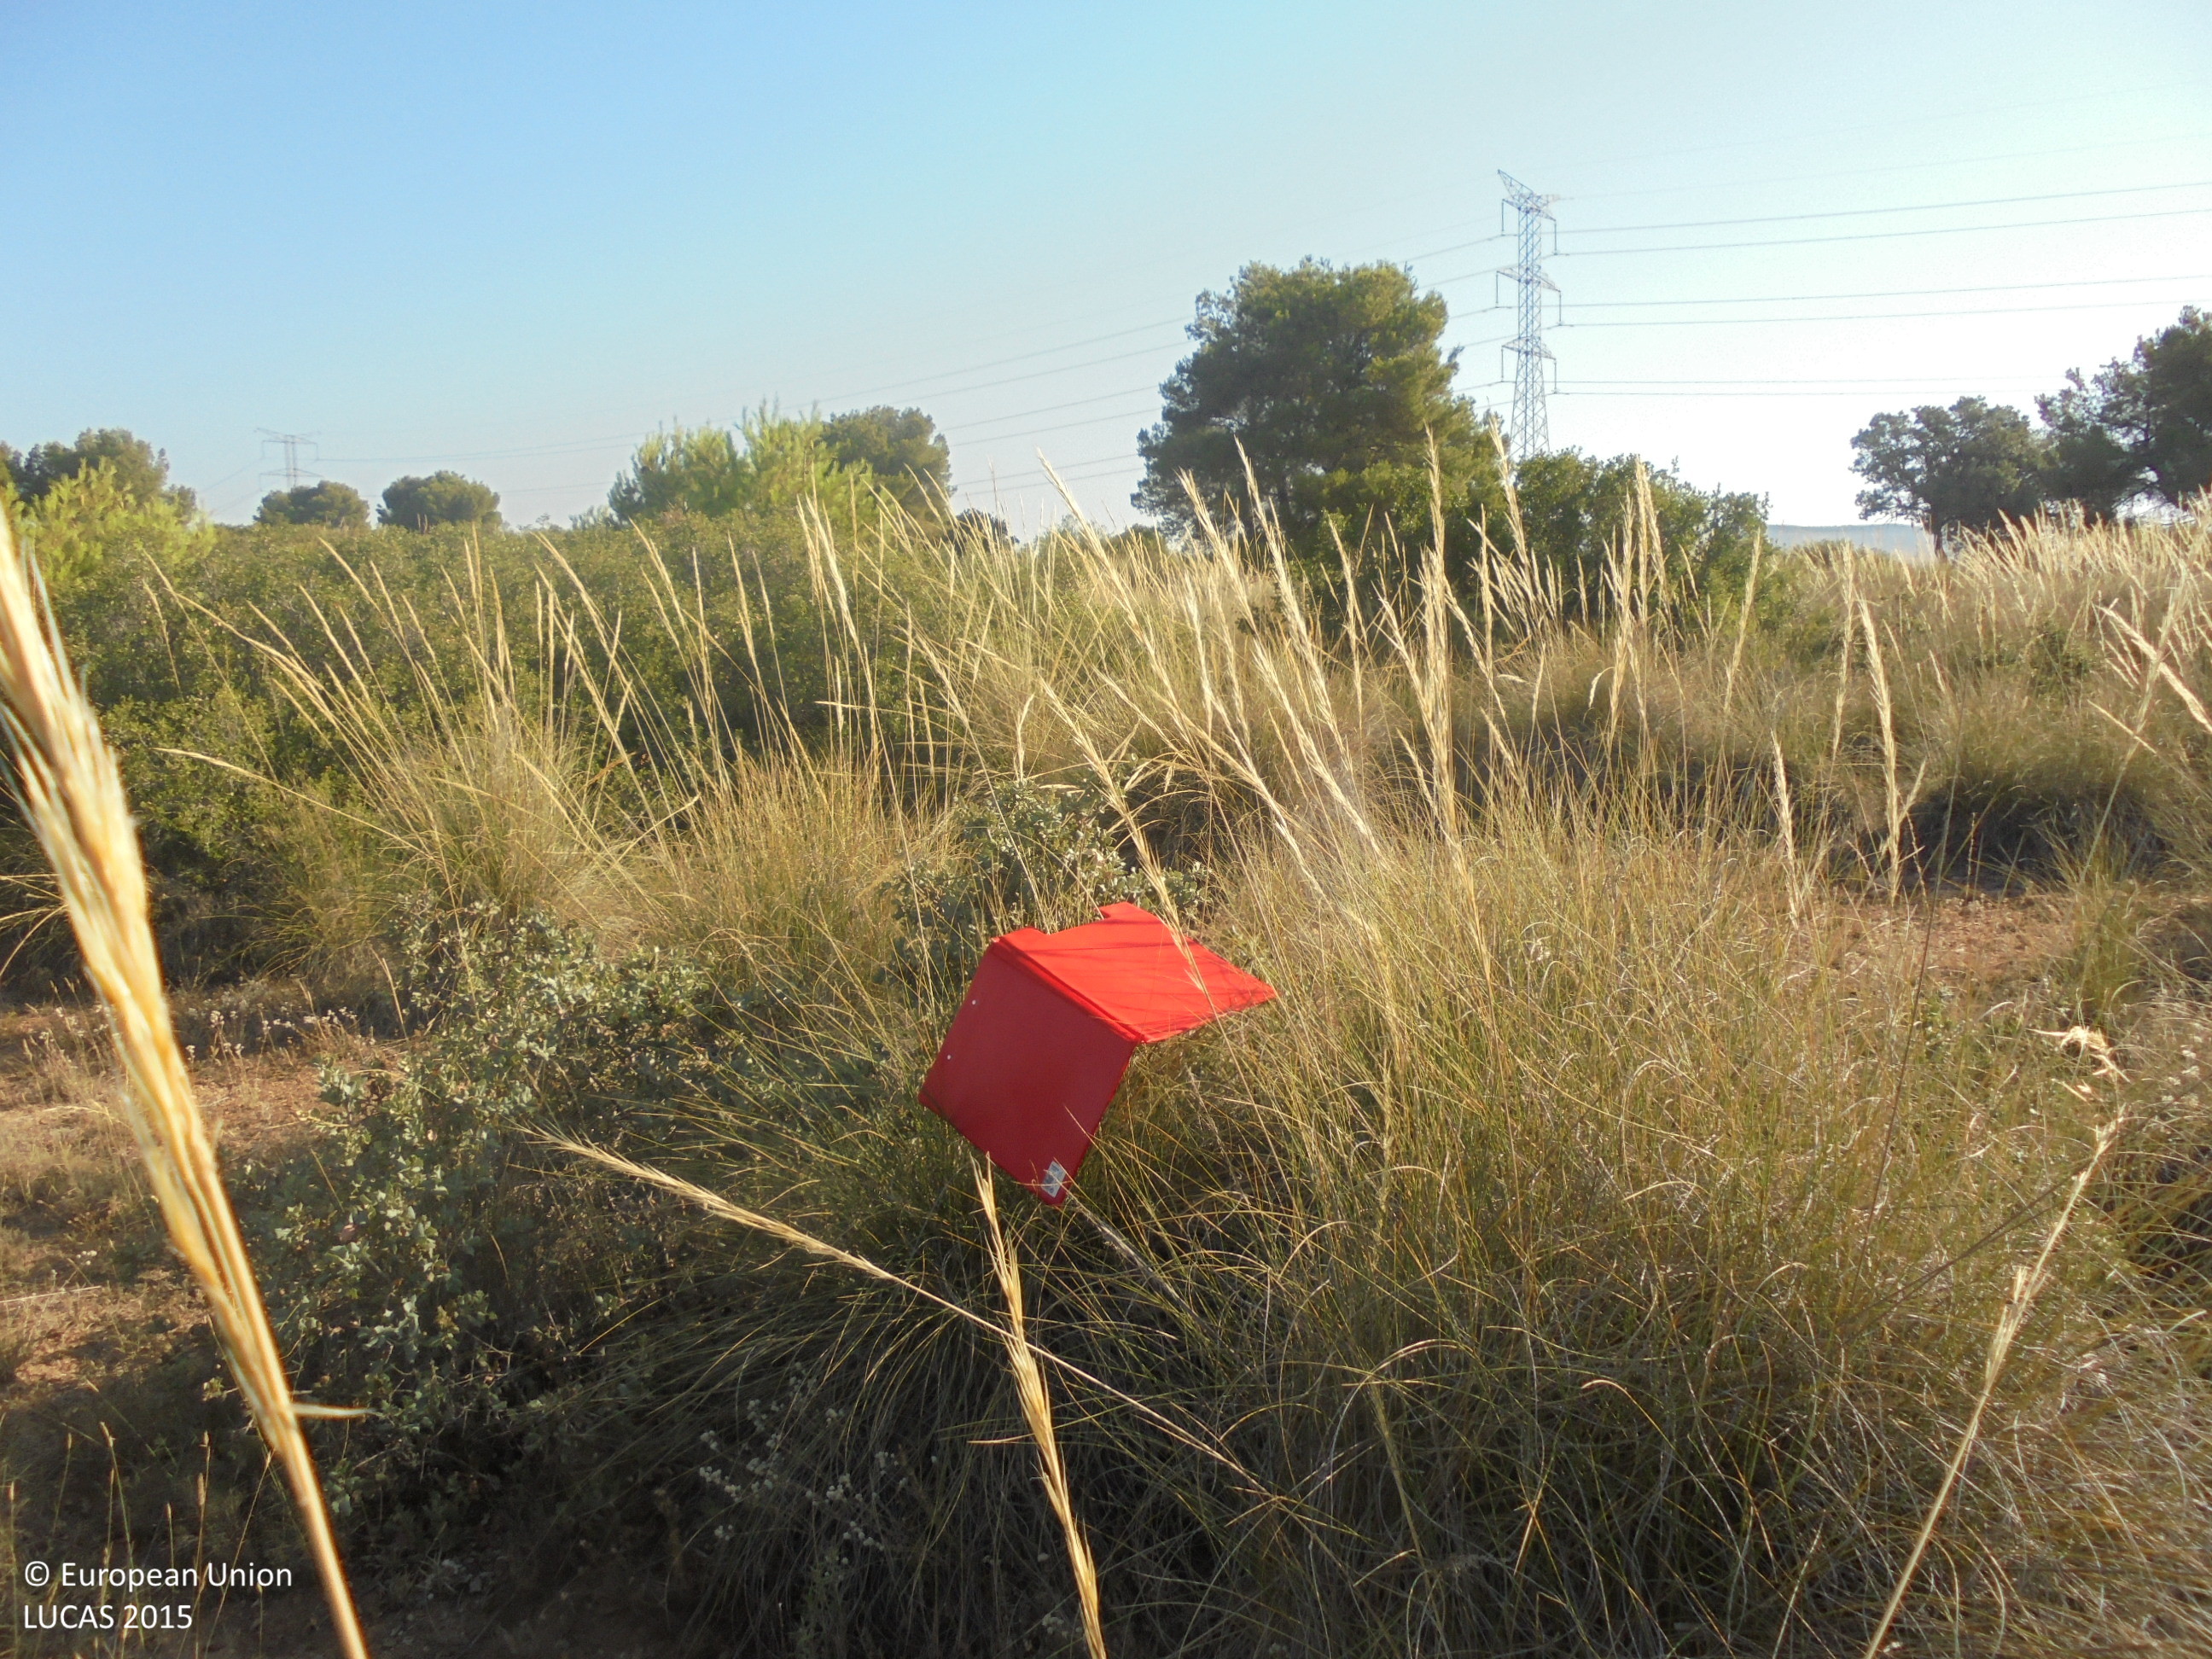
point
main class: Shrubland
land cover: Shrubland with sparse tree cover
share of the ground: > 75 %
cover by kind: shrubs 80 %, unconsolidated bare surface 15 %, coniferous forest trees 5 %
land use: Semi-natural and natural areas not in use
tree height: < 5 m
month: July
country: ES
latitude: 38.7056
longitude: -1.5515
